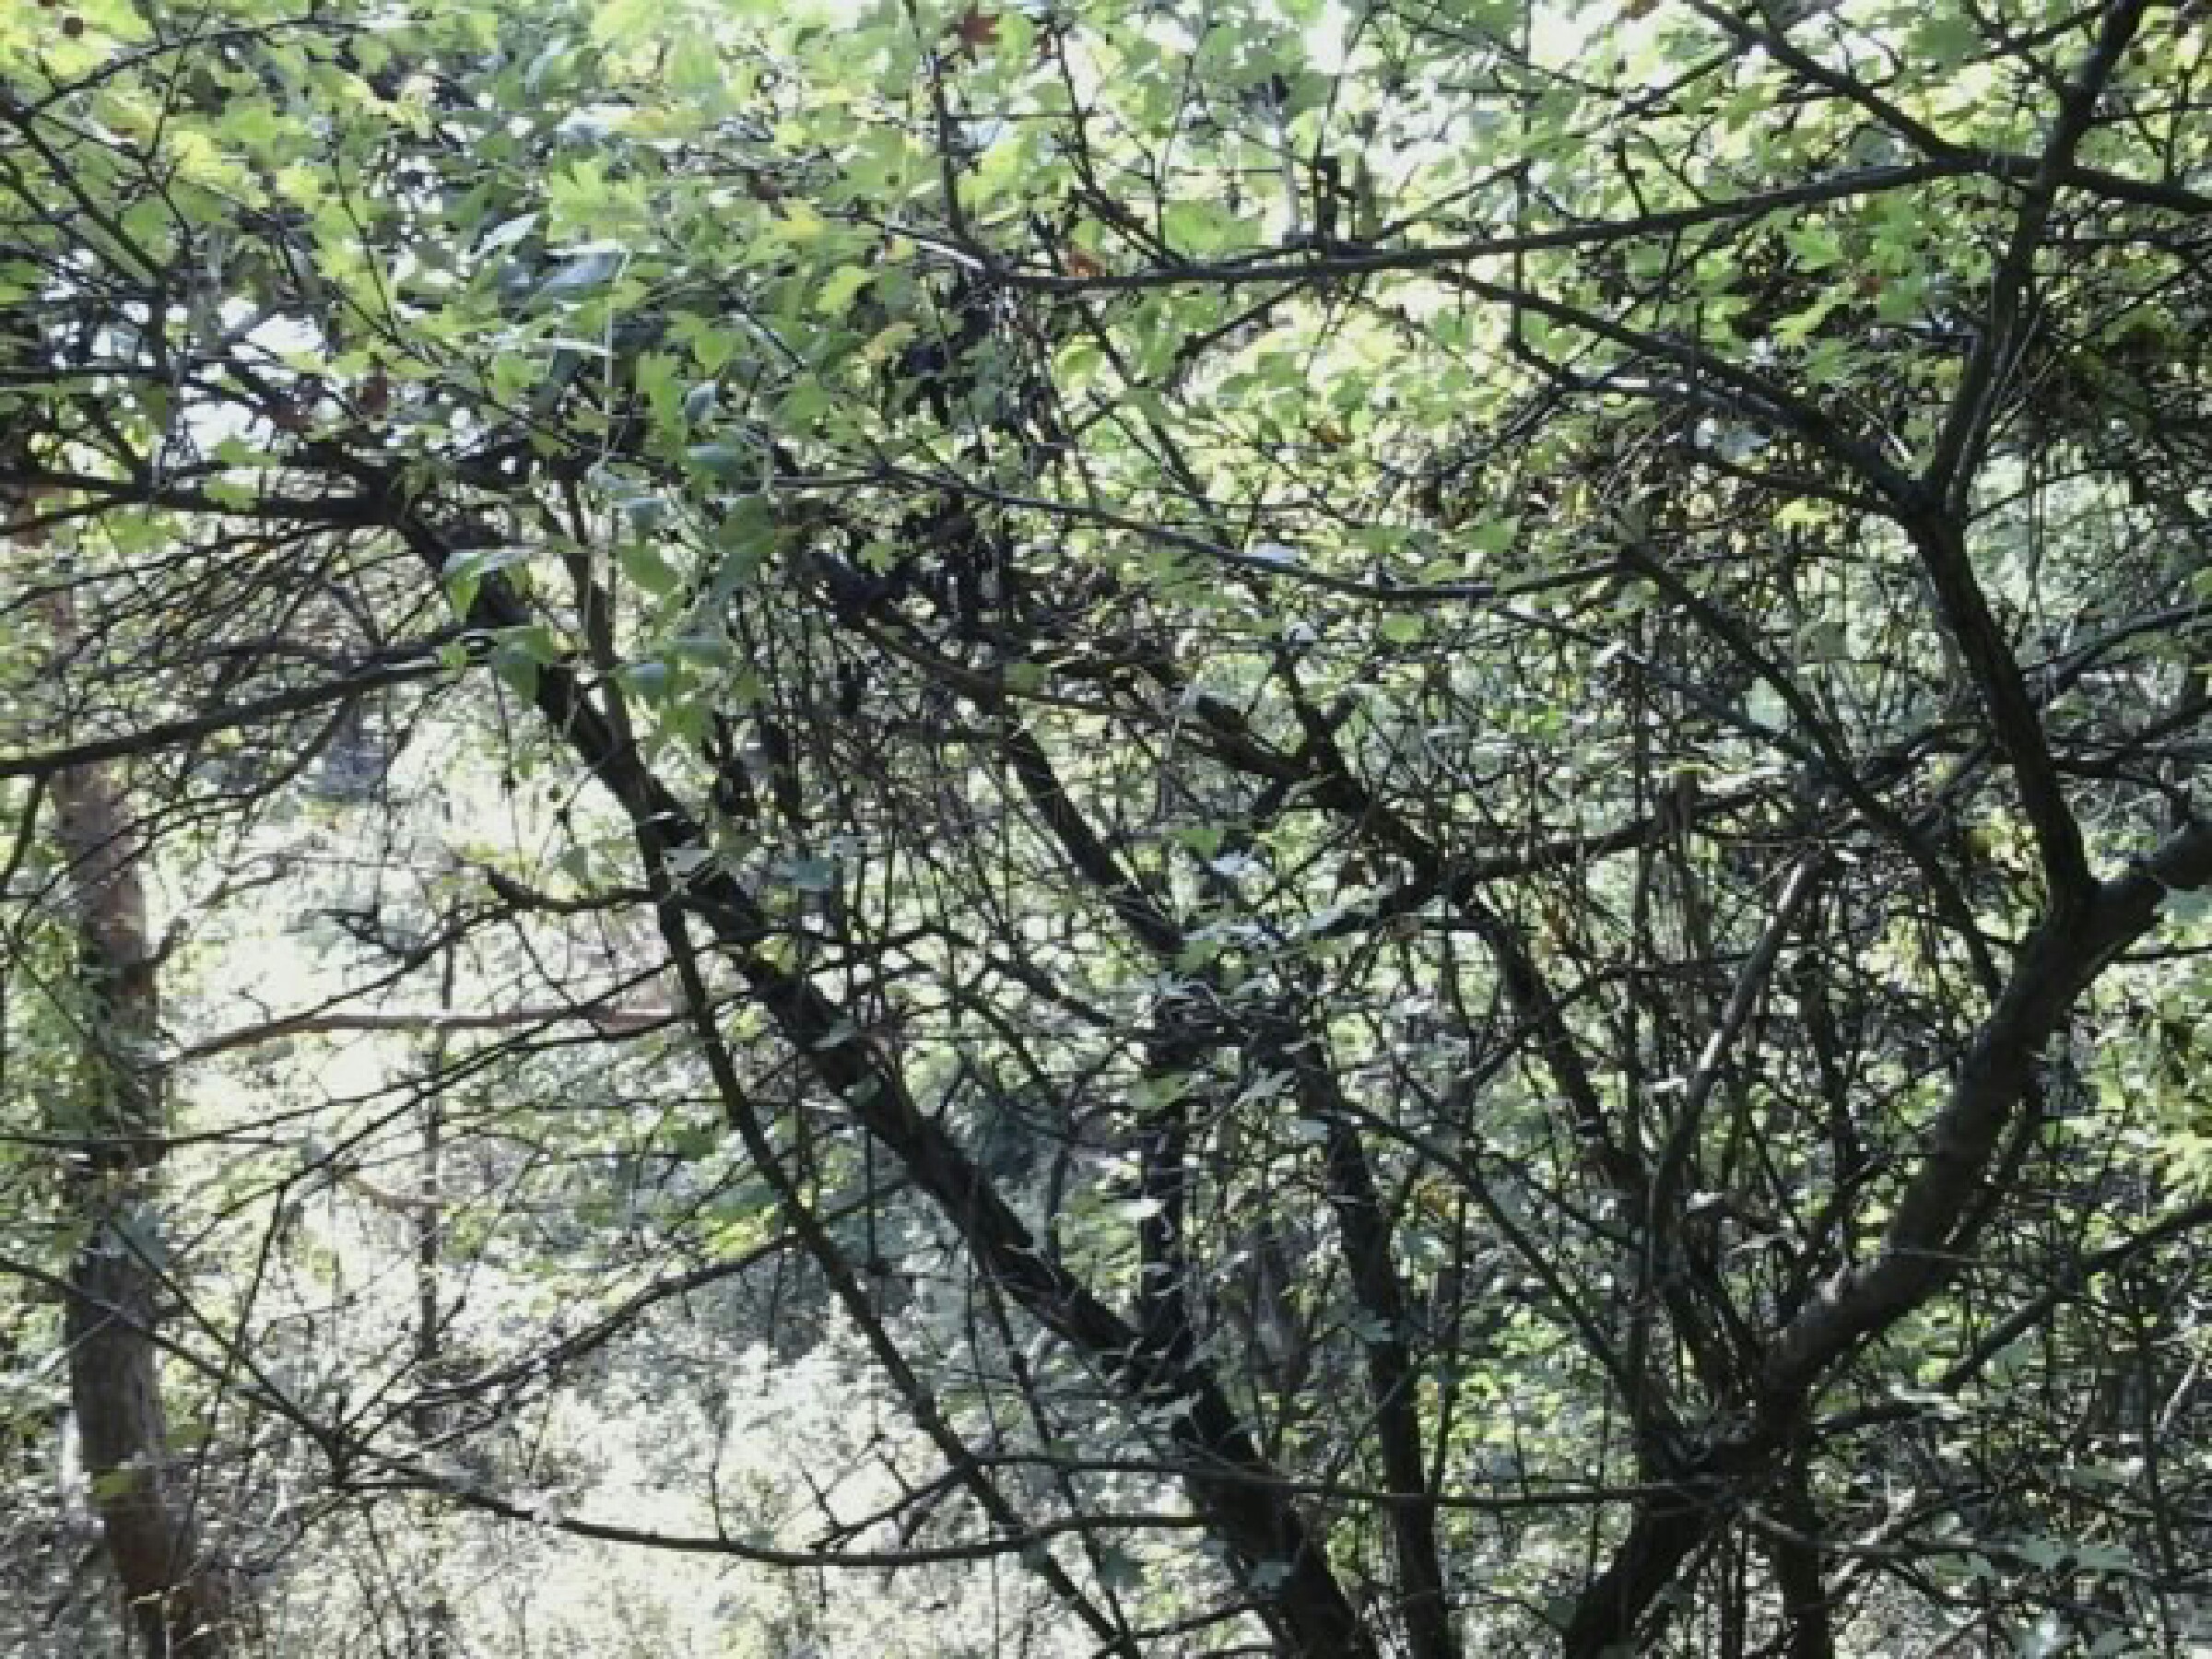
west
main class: Woodland
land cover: Pine dominated mixed woodland
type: hemiboreal forest and nemoral coniferous forest and mixed broadleaved-coniferous forest
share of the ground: > 75 %
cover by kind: coniferous forest trees 60 %, broadleaved forest trees 40 %
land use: Forestry
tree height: > 5 m
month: August
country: HU
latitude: 47.9806
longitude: 19.4412
